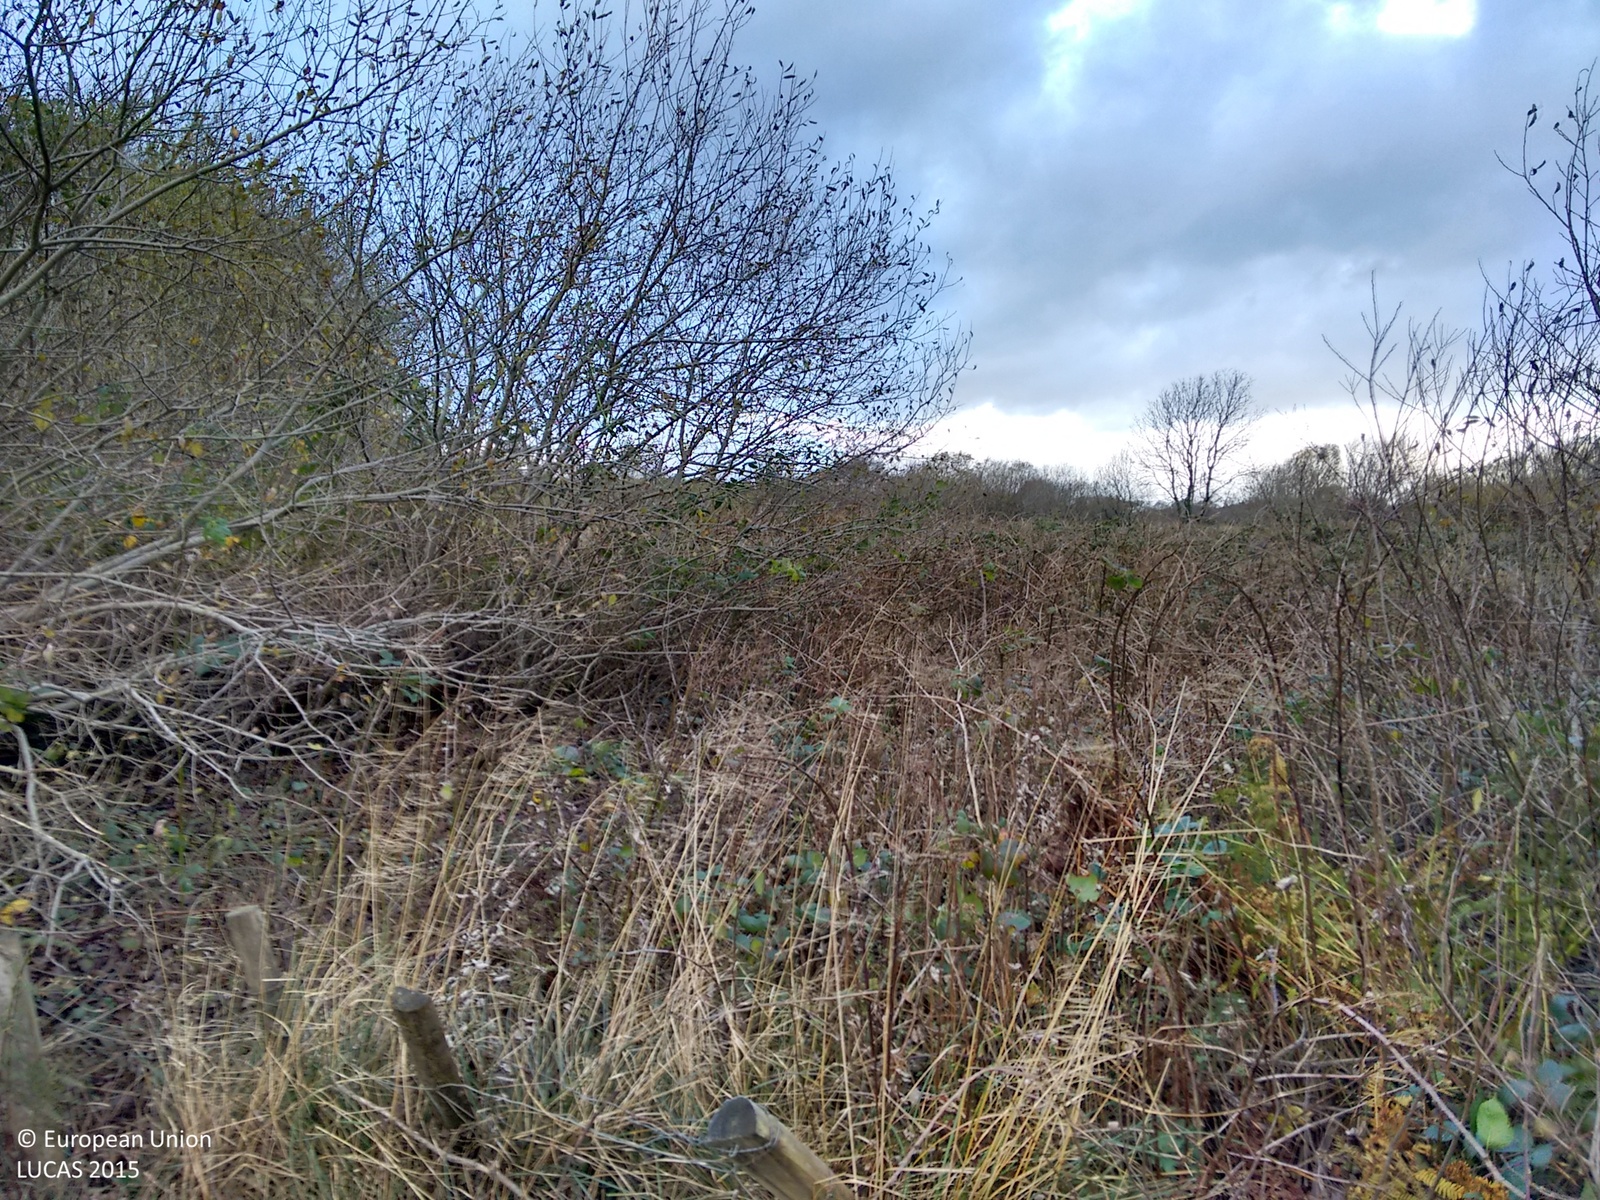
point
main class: Shrubland
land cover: Shrubland without tree cover
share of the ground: > 75 %
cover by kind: shrubs 70 %, herbaceous plants 30 %
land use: Agriculture (excluding fallow land and kitchen gardens)
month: November
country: IE
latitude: 54.7848
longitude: -8.2660
